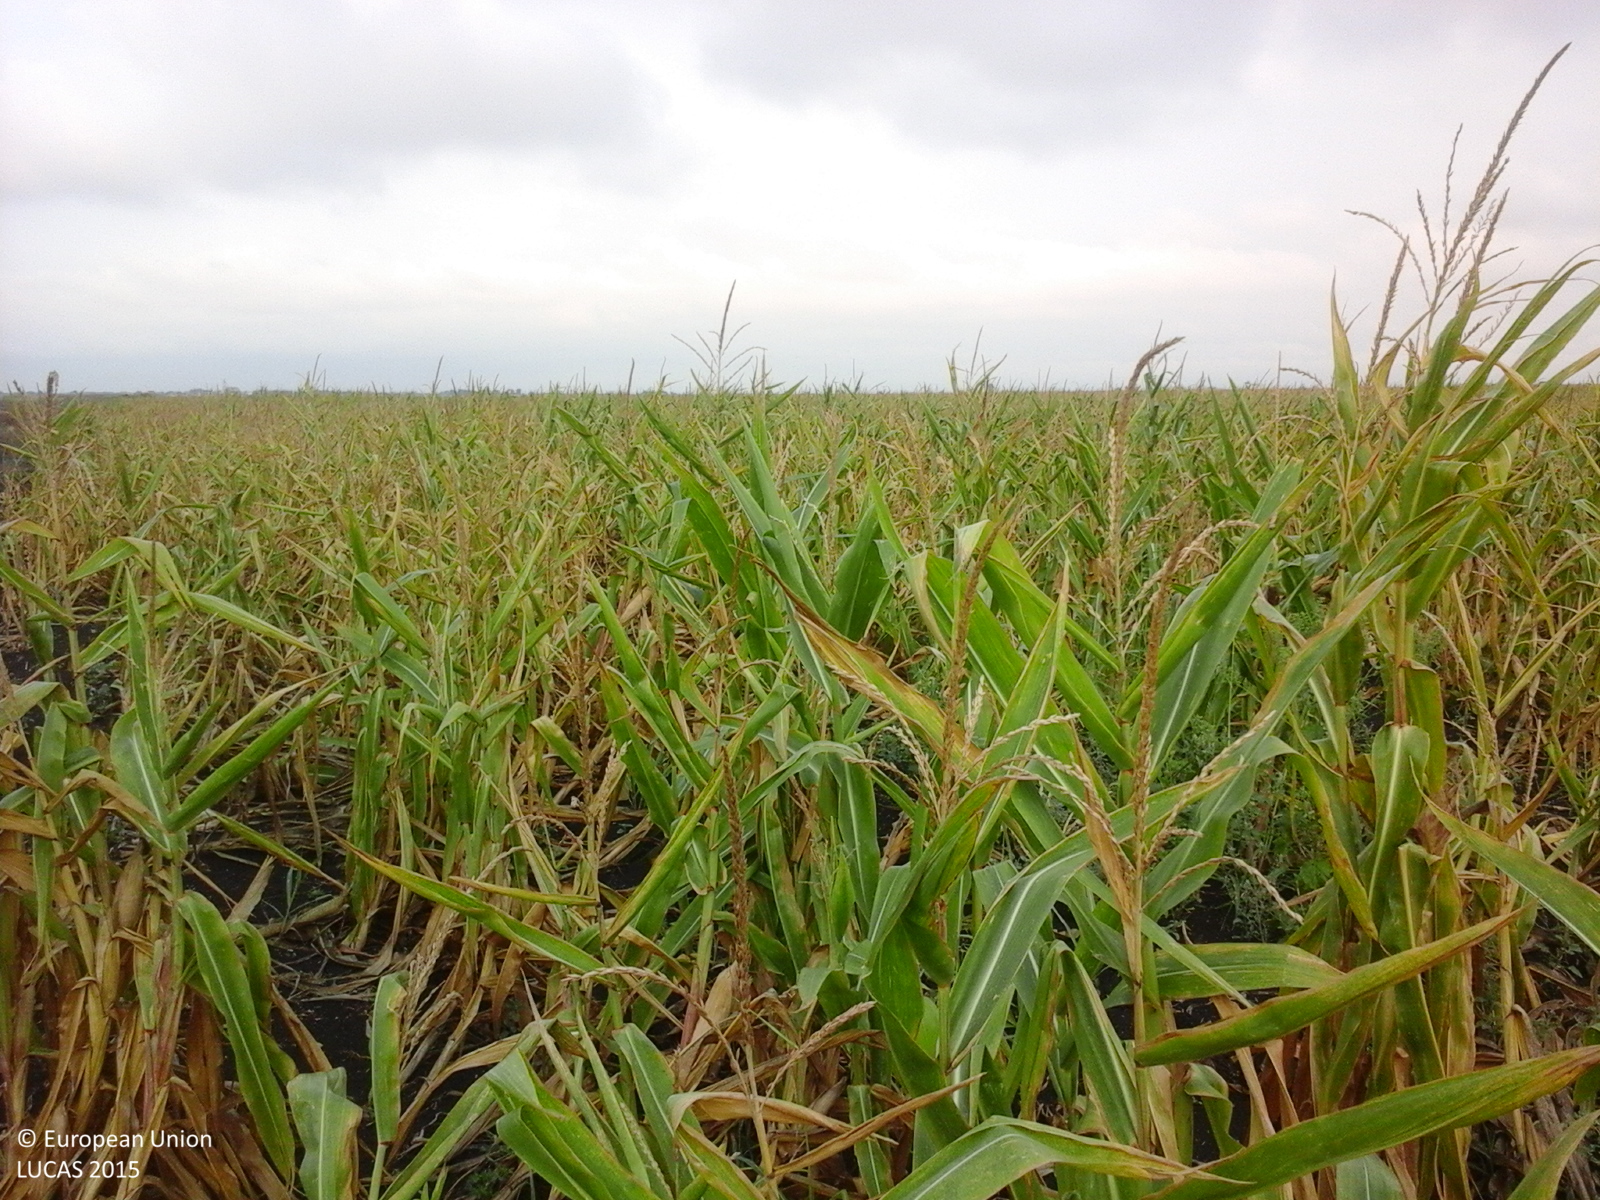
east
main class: Cropland
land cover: Maize
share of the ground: > 75 %
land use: Agriculture (excluding fallow land and kitchen gardens)
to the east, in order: Maize; Grassland without tree/shrub cover
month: August
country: RO
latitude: 45.9587
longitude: 20.5141
